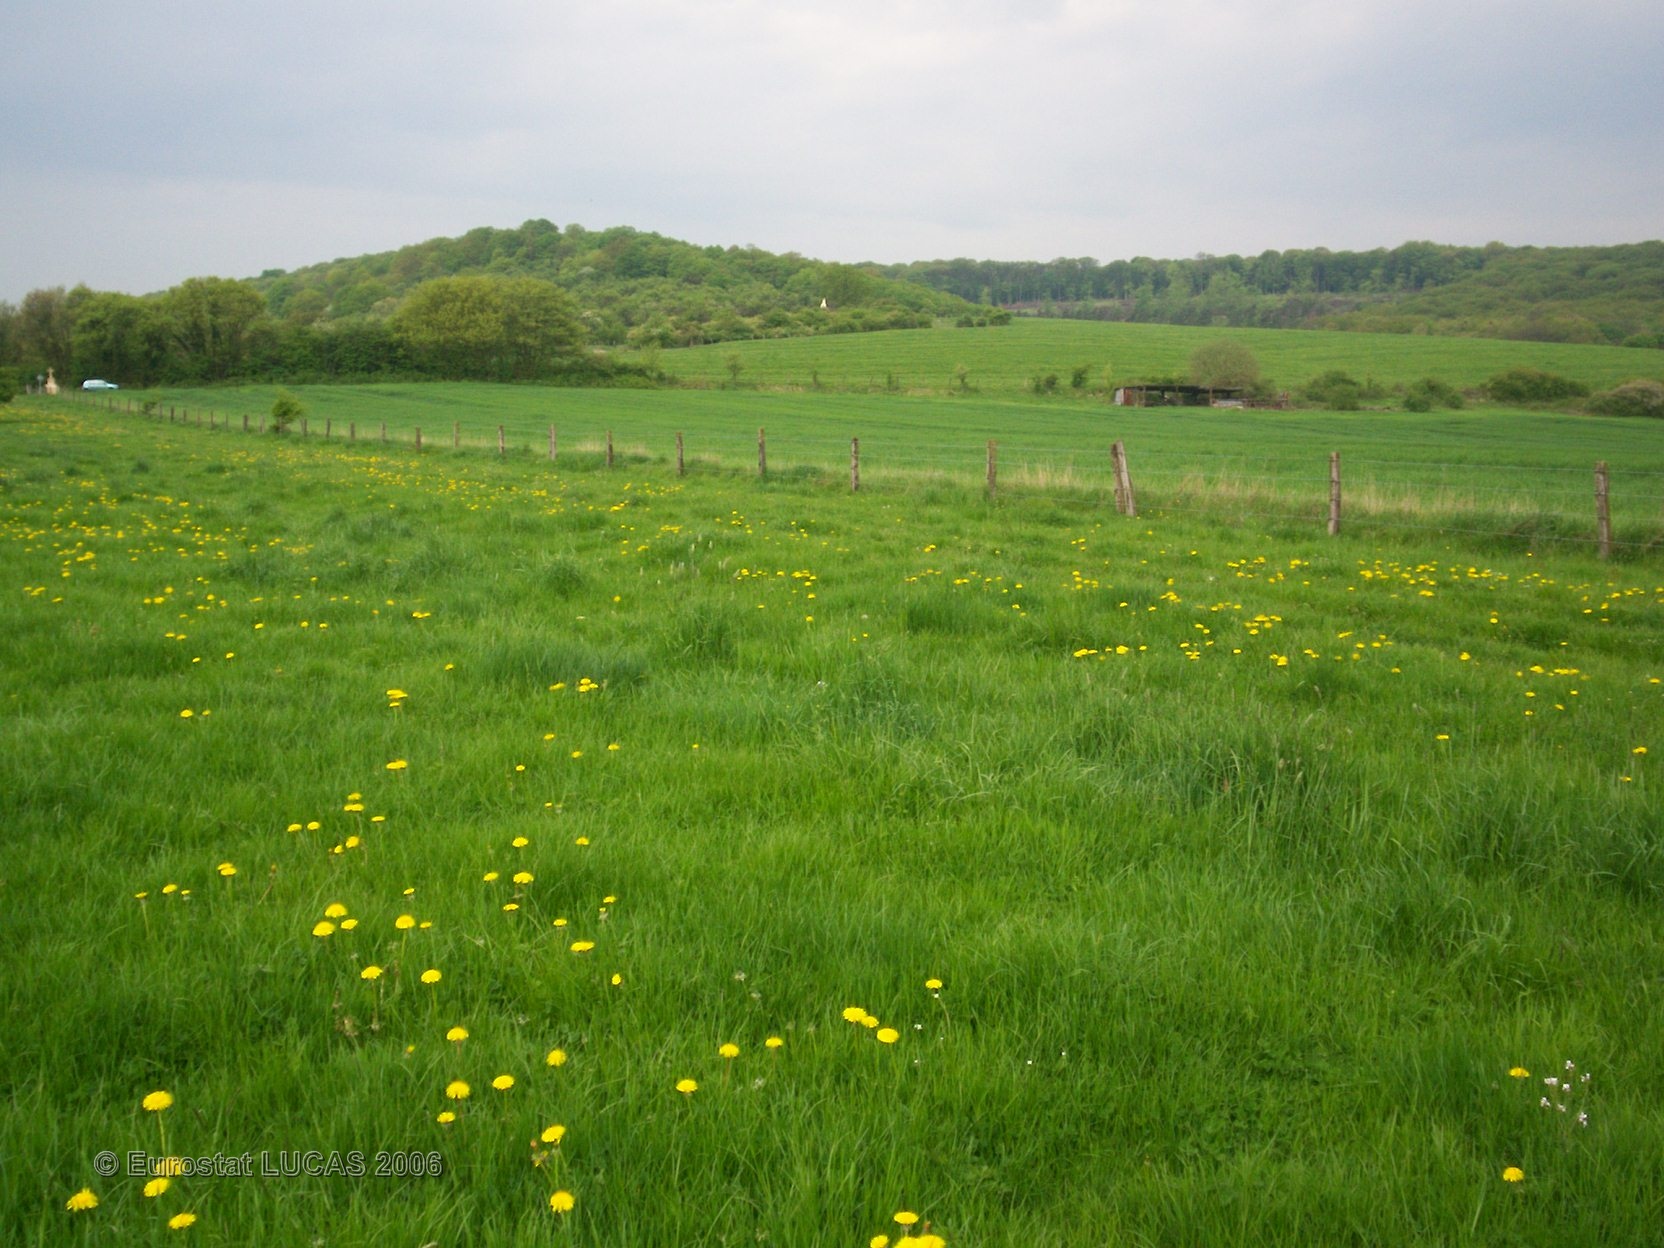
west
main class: Grassland
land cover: Grassland without tree/shrub cover
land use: Agriculture (excluding fallow land and kitchen gardens)
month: May
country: FR
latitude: 49.1748
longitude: 6.4472
